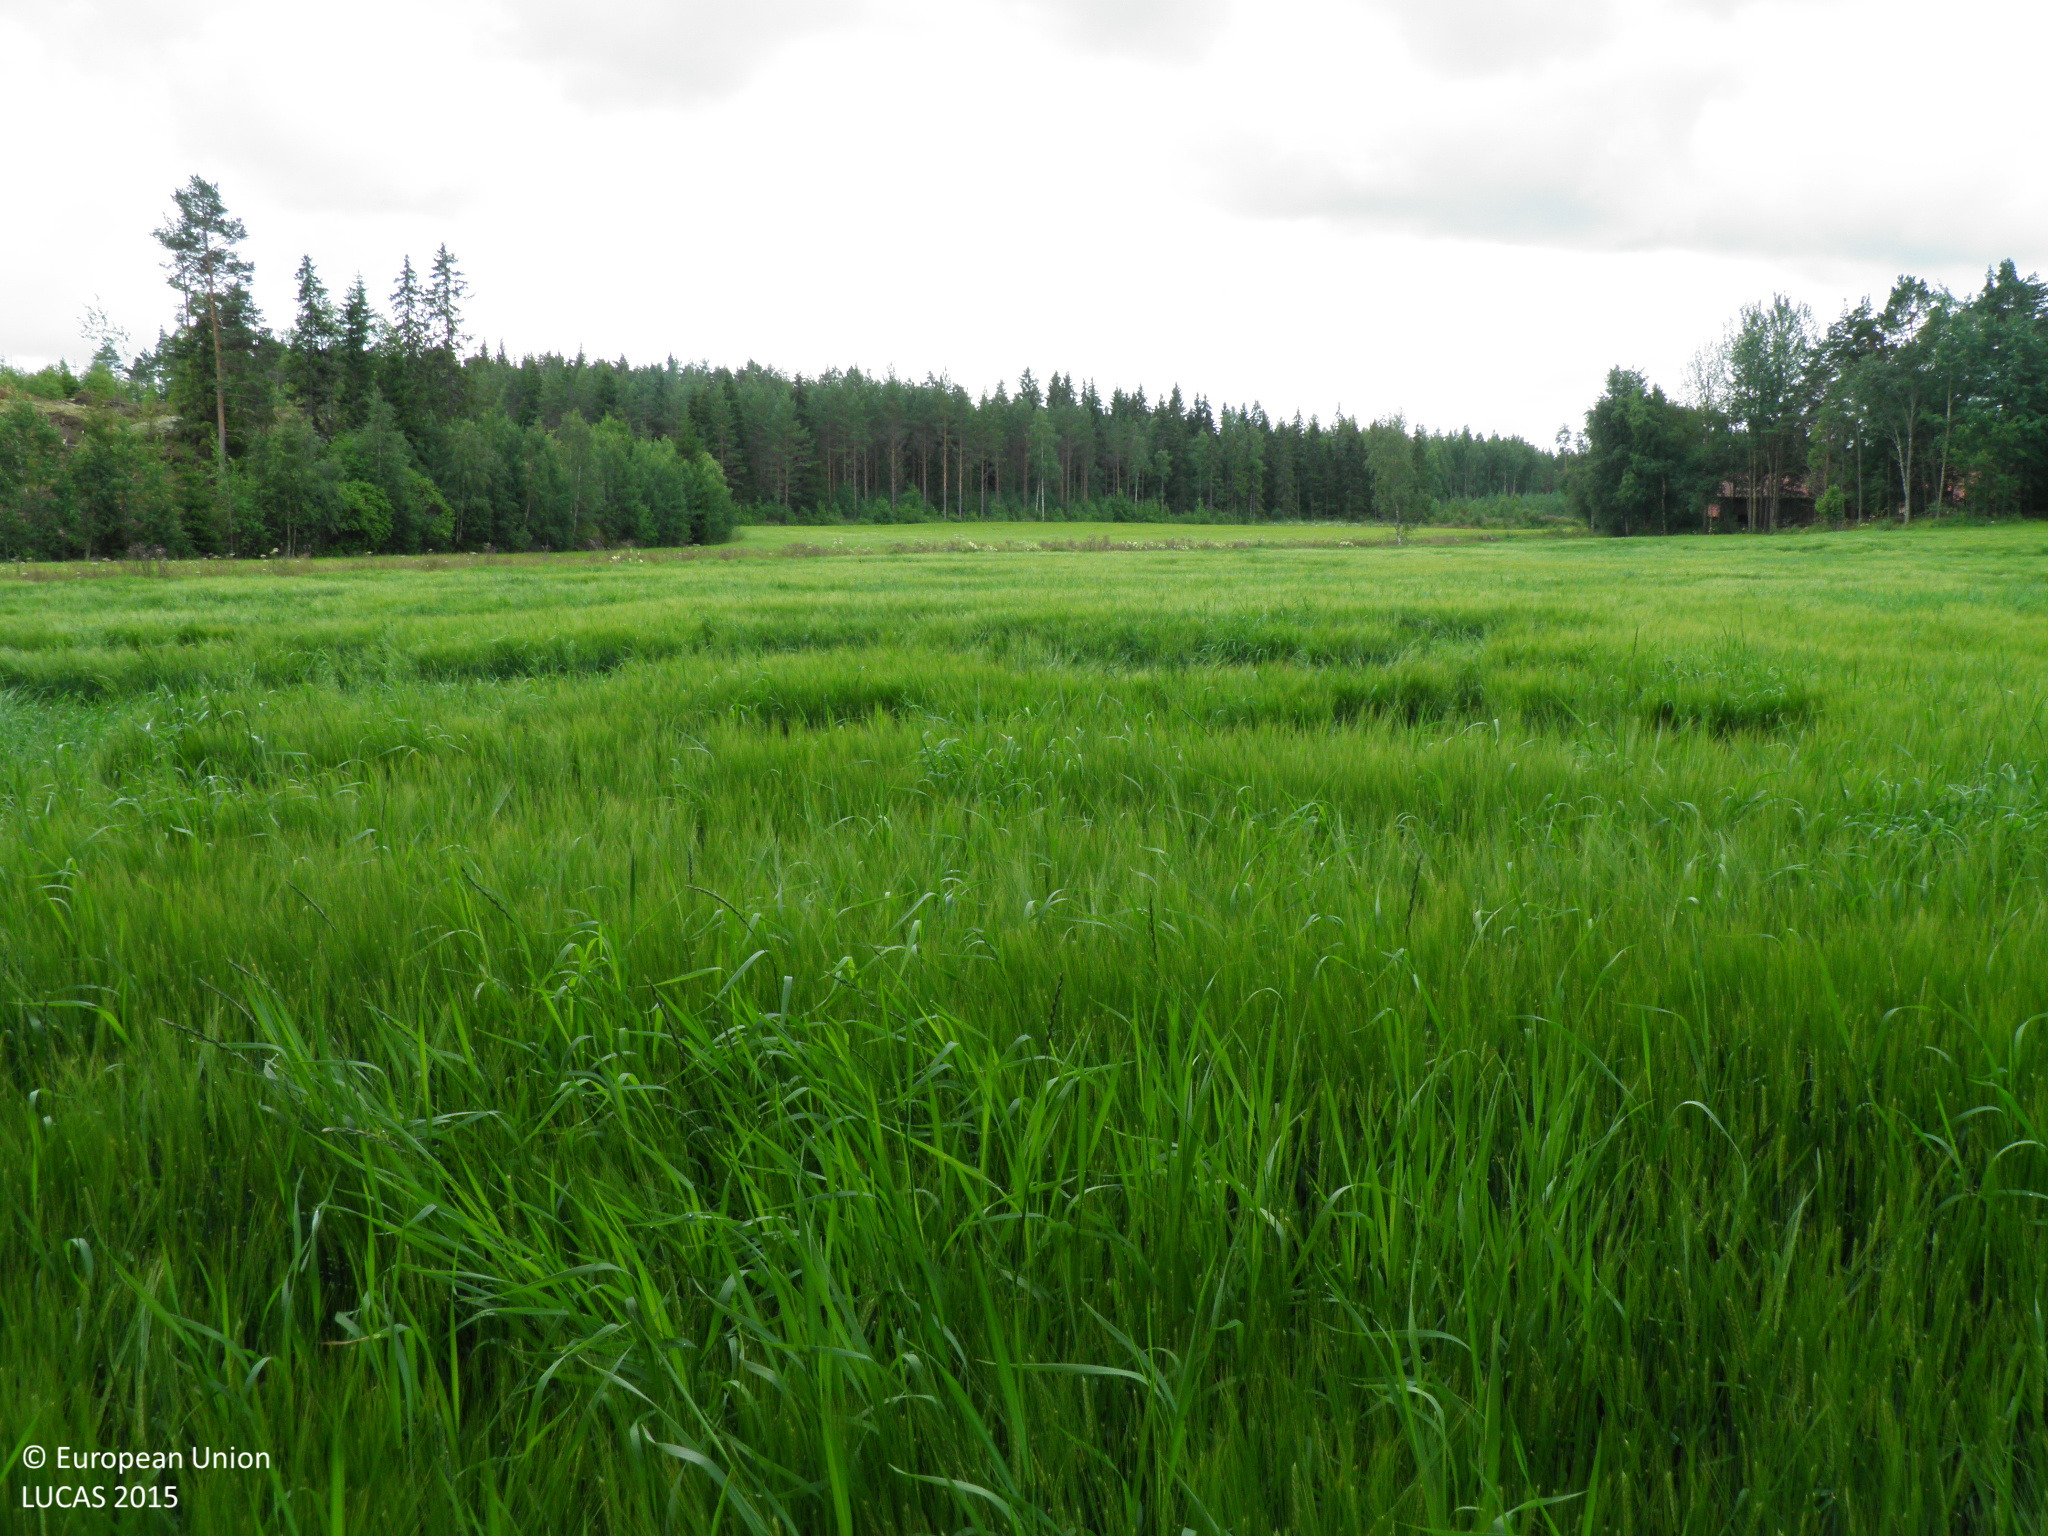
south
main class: Cropland
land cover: Barley
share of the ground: > 75 %
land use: Agriculture (excluding fallow land and kitchen gardens)
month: July
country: FI
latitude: 60.7044
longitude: 21.5803
